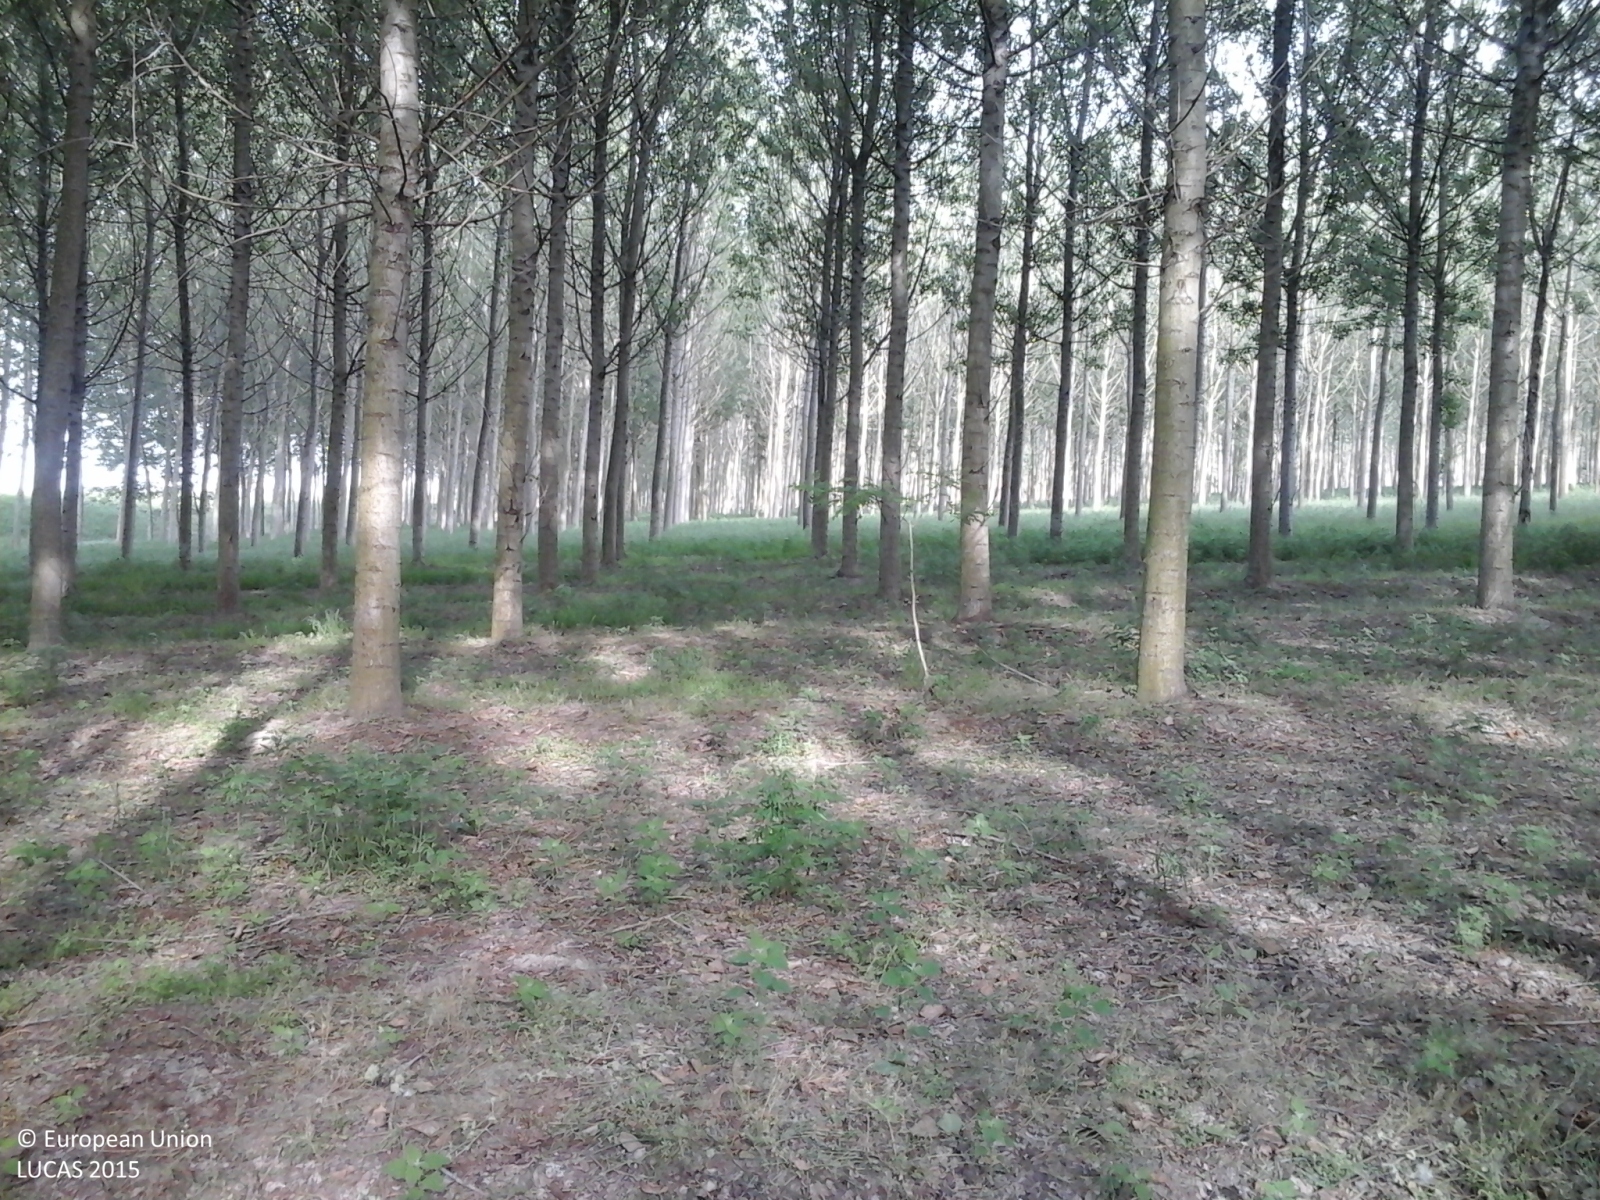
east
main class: Woodland
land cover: Broadleaved woodland
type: non-riverine alder, birch or aspen forest
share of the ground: > 75 %
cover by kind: broadleaved forest trees 80 %, herbaceous plants 20 %
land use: Forestry
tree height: > 5 m
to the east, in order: Broadleaved woodland
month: May
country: IT
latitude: 45.1810
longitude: 8.1072
